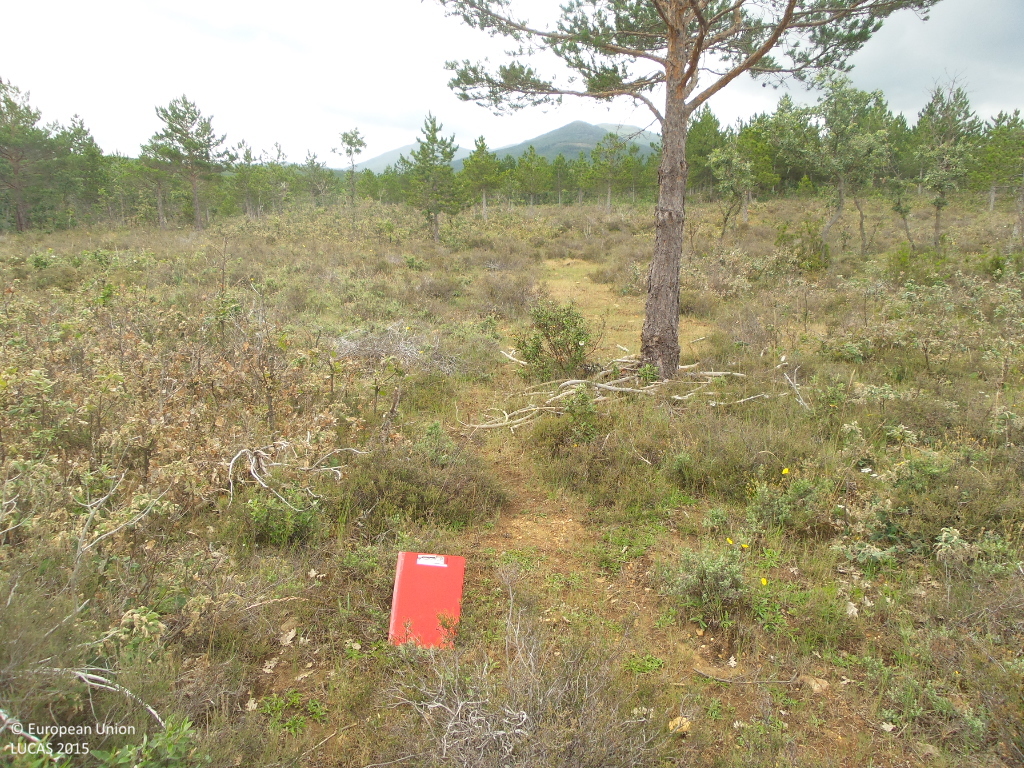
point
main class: Shrubland
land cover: Shrubland with sparse tree cover
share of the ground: > 75 %
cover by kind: shrubs 80 %, coniferous forest trees 5 %, herbaceous plants 5 %, lichens and mosses 5 %, unconsolidated bare surface 5 %
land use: Forestry
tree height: < 5 m
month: June
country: ES
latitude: 41.3153
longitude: -3.4361
